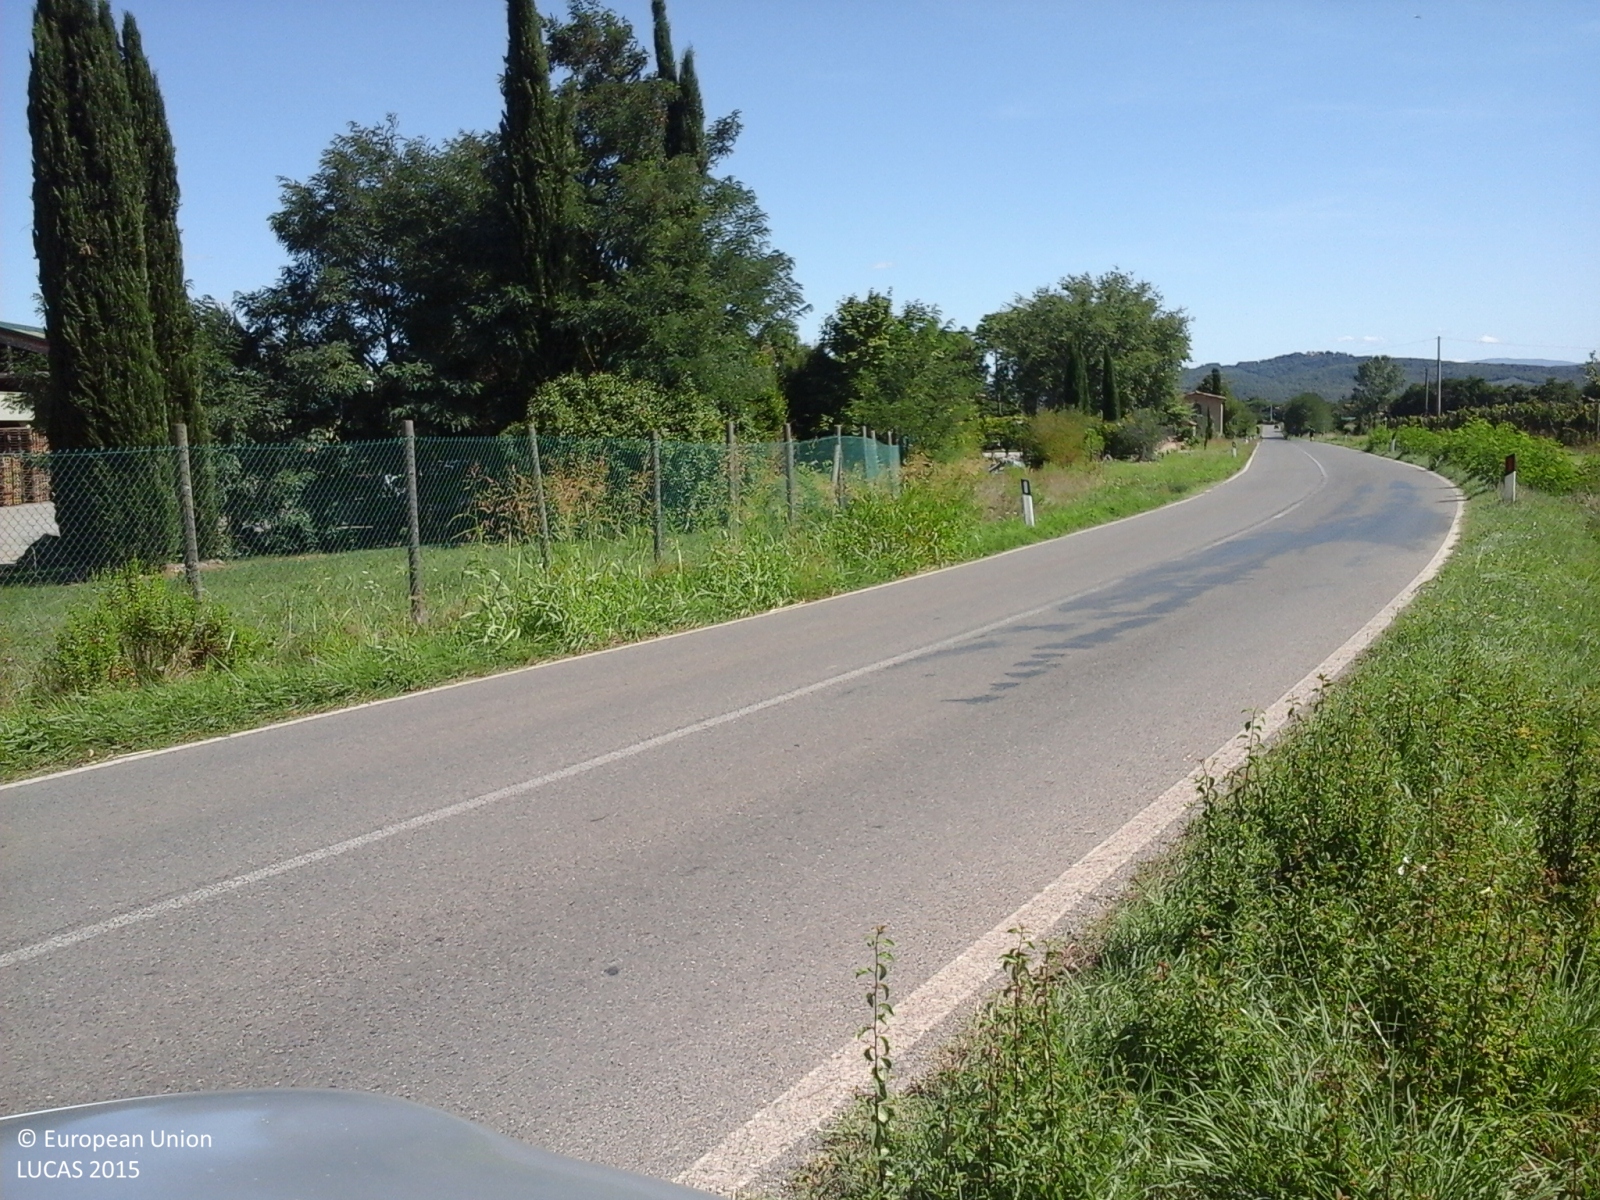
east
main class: Cropland
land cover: Vineyards
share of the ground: 25 - 50 %
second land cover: Grassland without tree/shrub cover
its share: > 75 %
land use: Agriculture (excluding fallow land and kitchen gardens)
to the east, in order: Vineyards; Grassland without tree/shrub cover; Artificial constructions in urban areas; Abandoned hedges; Durum wheat; Abandoned hedges; Durum wheat; Tracks; Grassland without tree/shrub cover
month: September
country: IT
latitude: 43.4722
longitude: 11.5903
